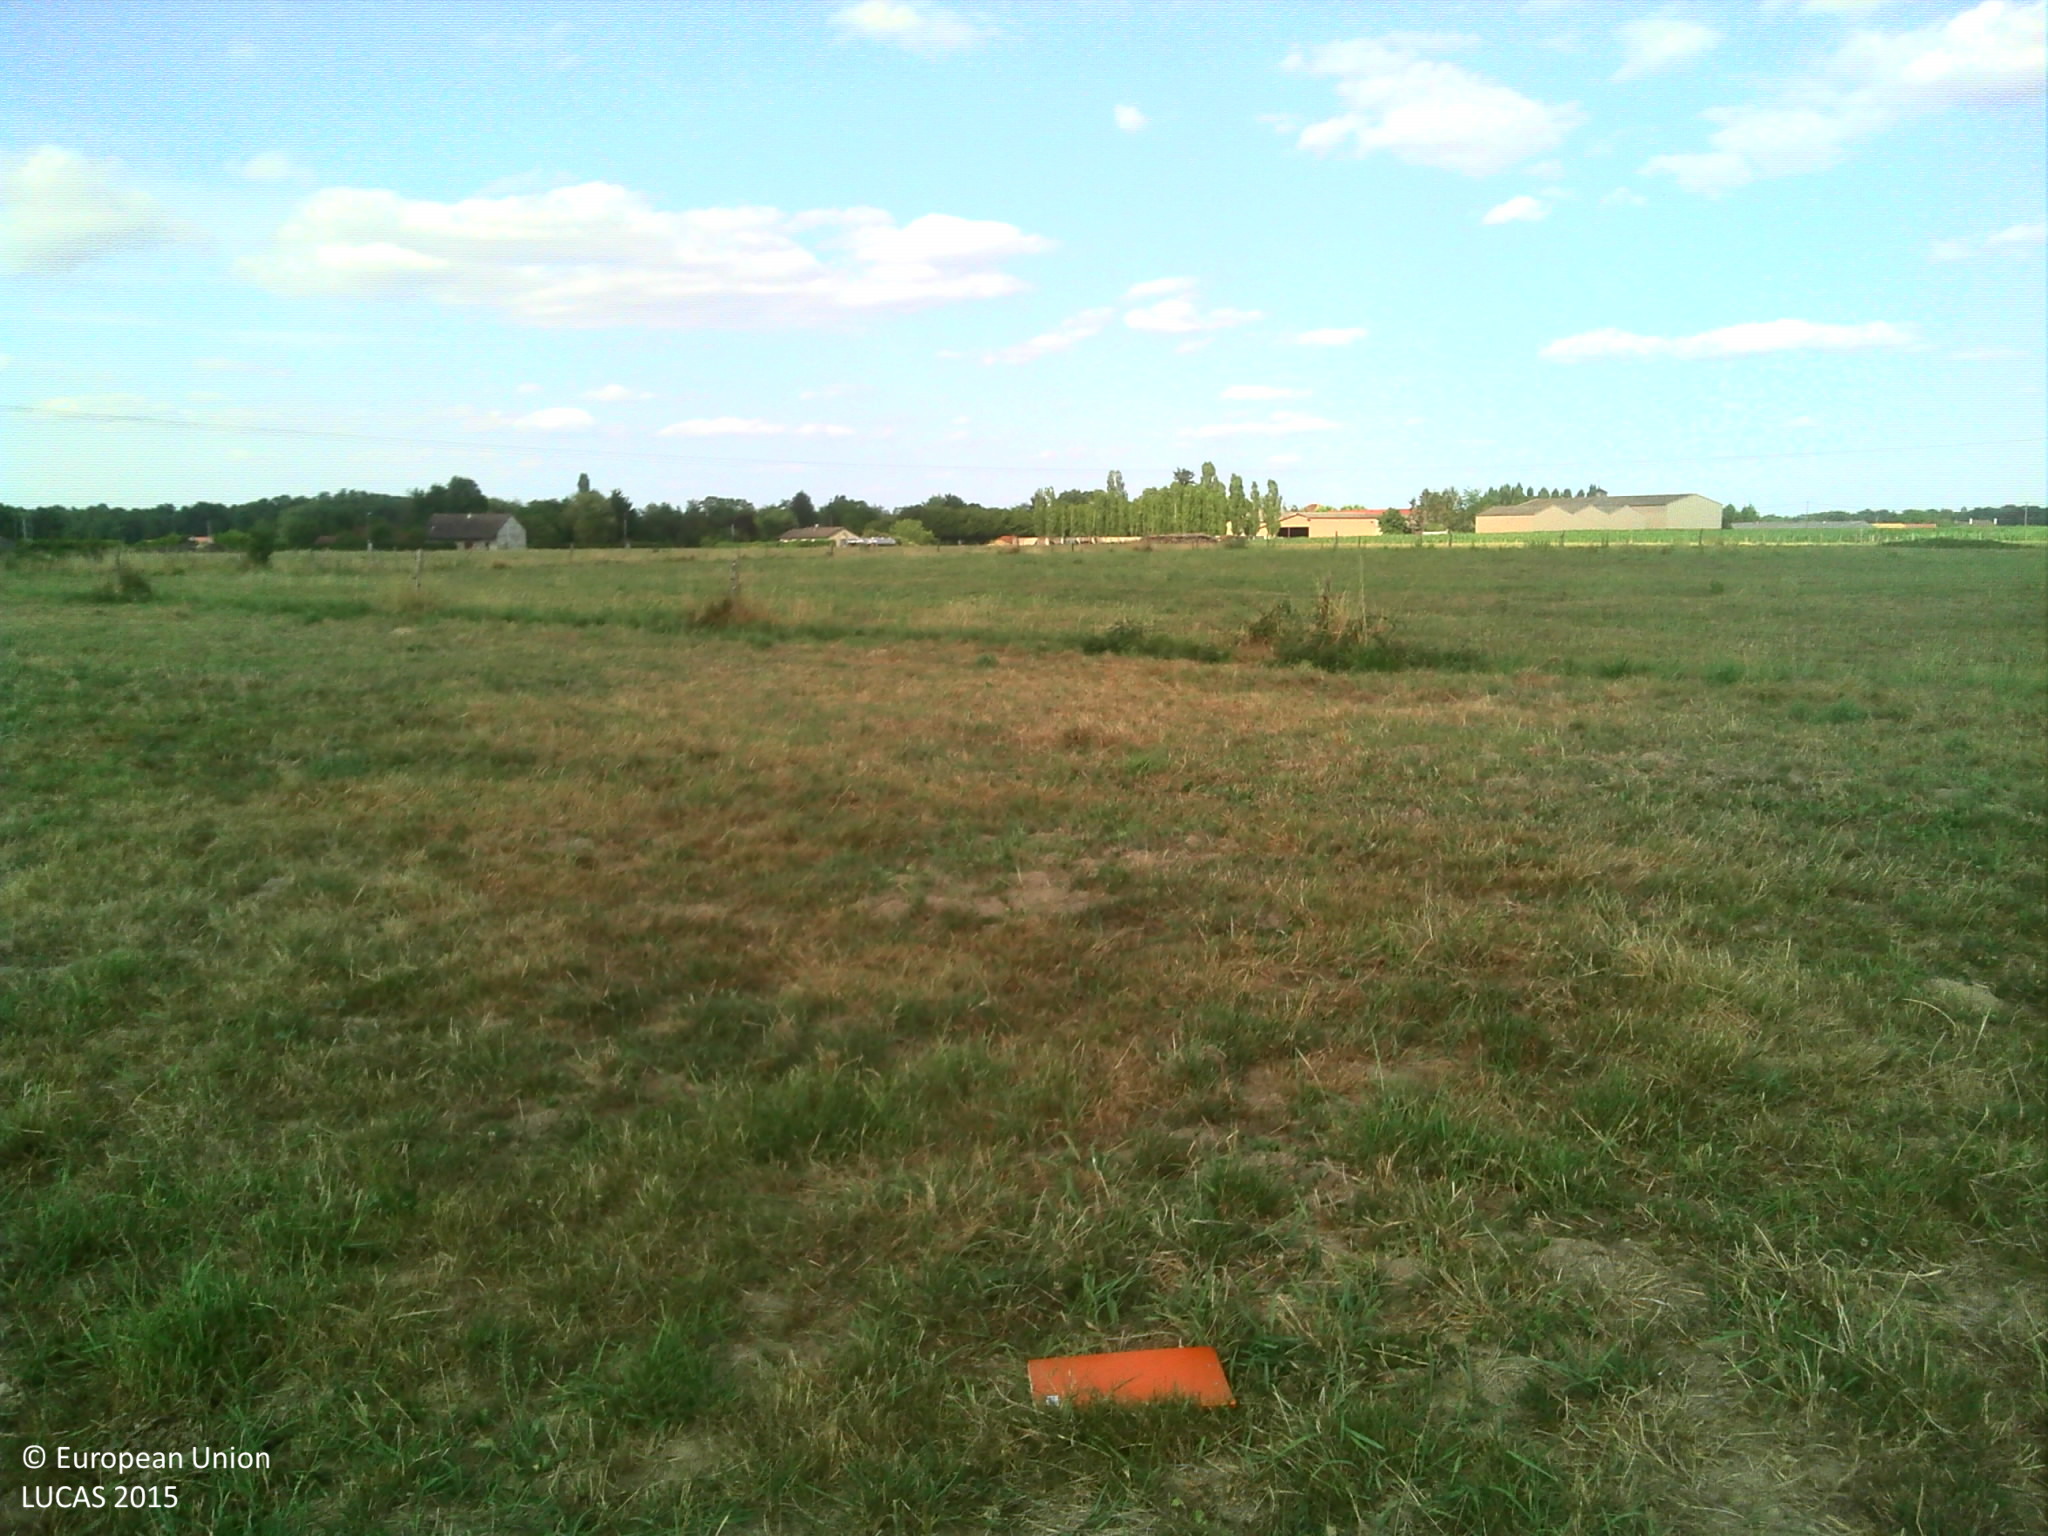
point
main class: Grassland
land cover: Grassland without tree/shrub cover
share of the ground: > 75 %
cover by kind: herbaceous plants 100 %
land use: Agriculture (excluding fallow land and kitchen gardens)
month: July
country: FR
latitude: 46.8516
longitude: 5.0834
